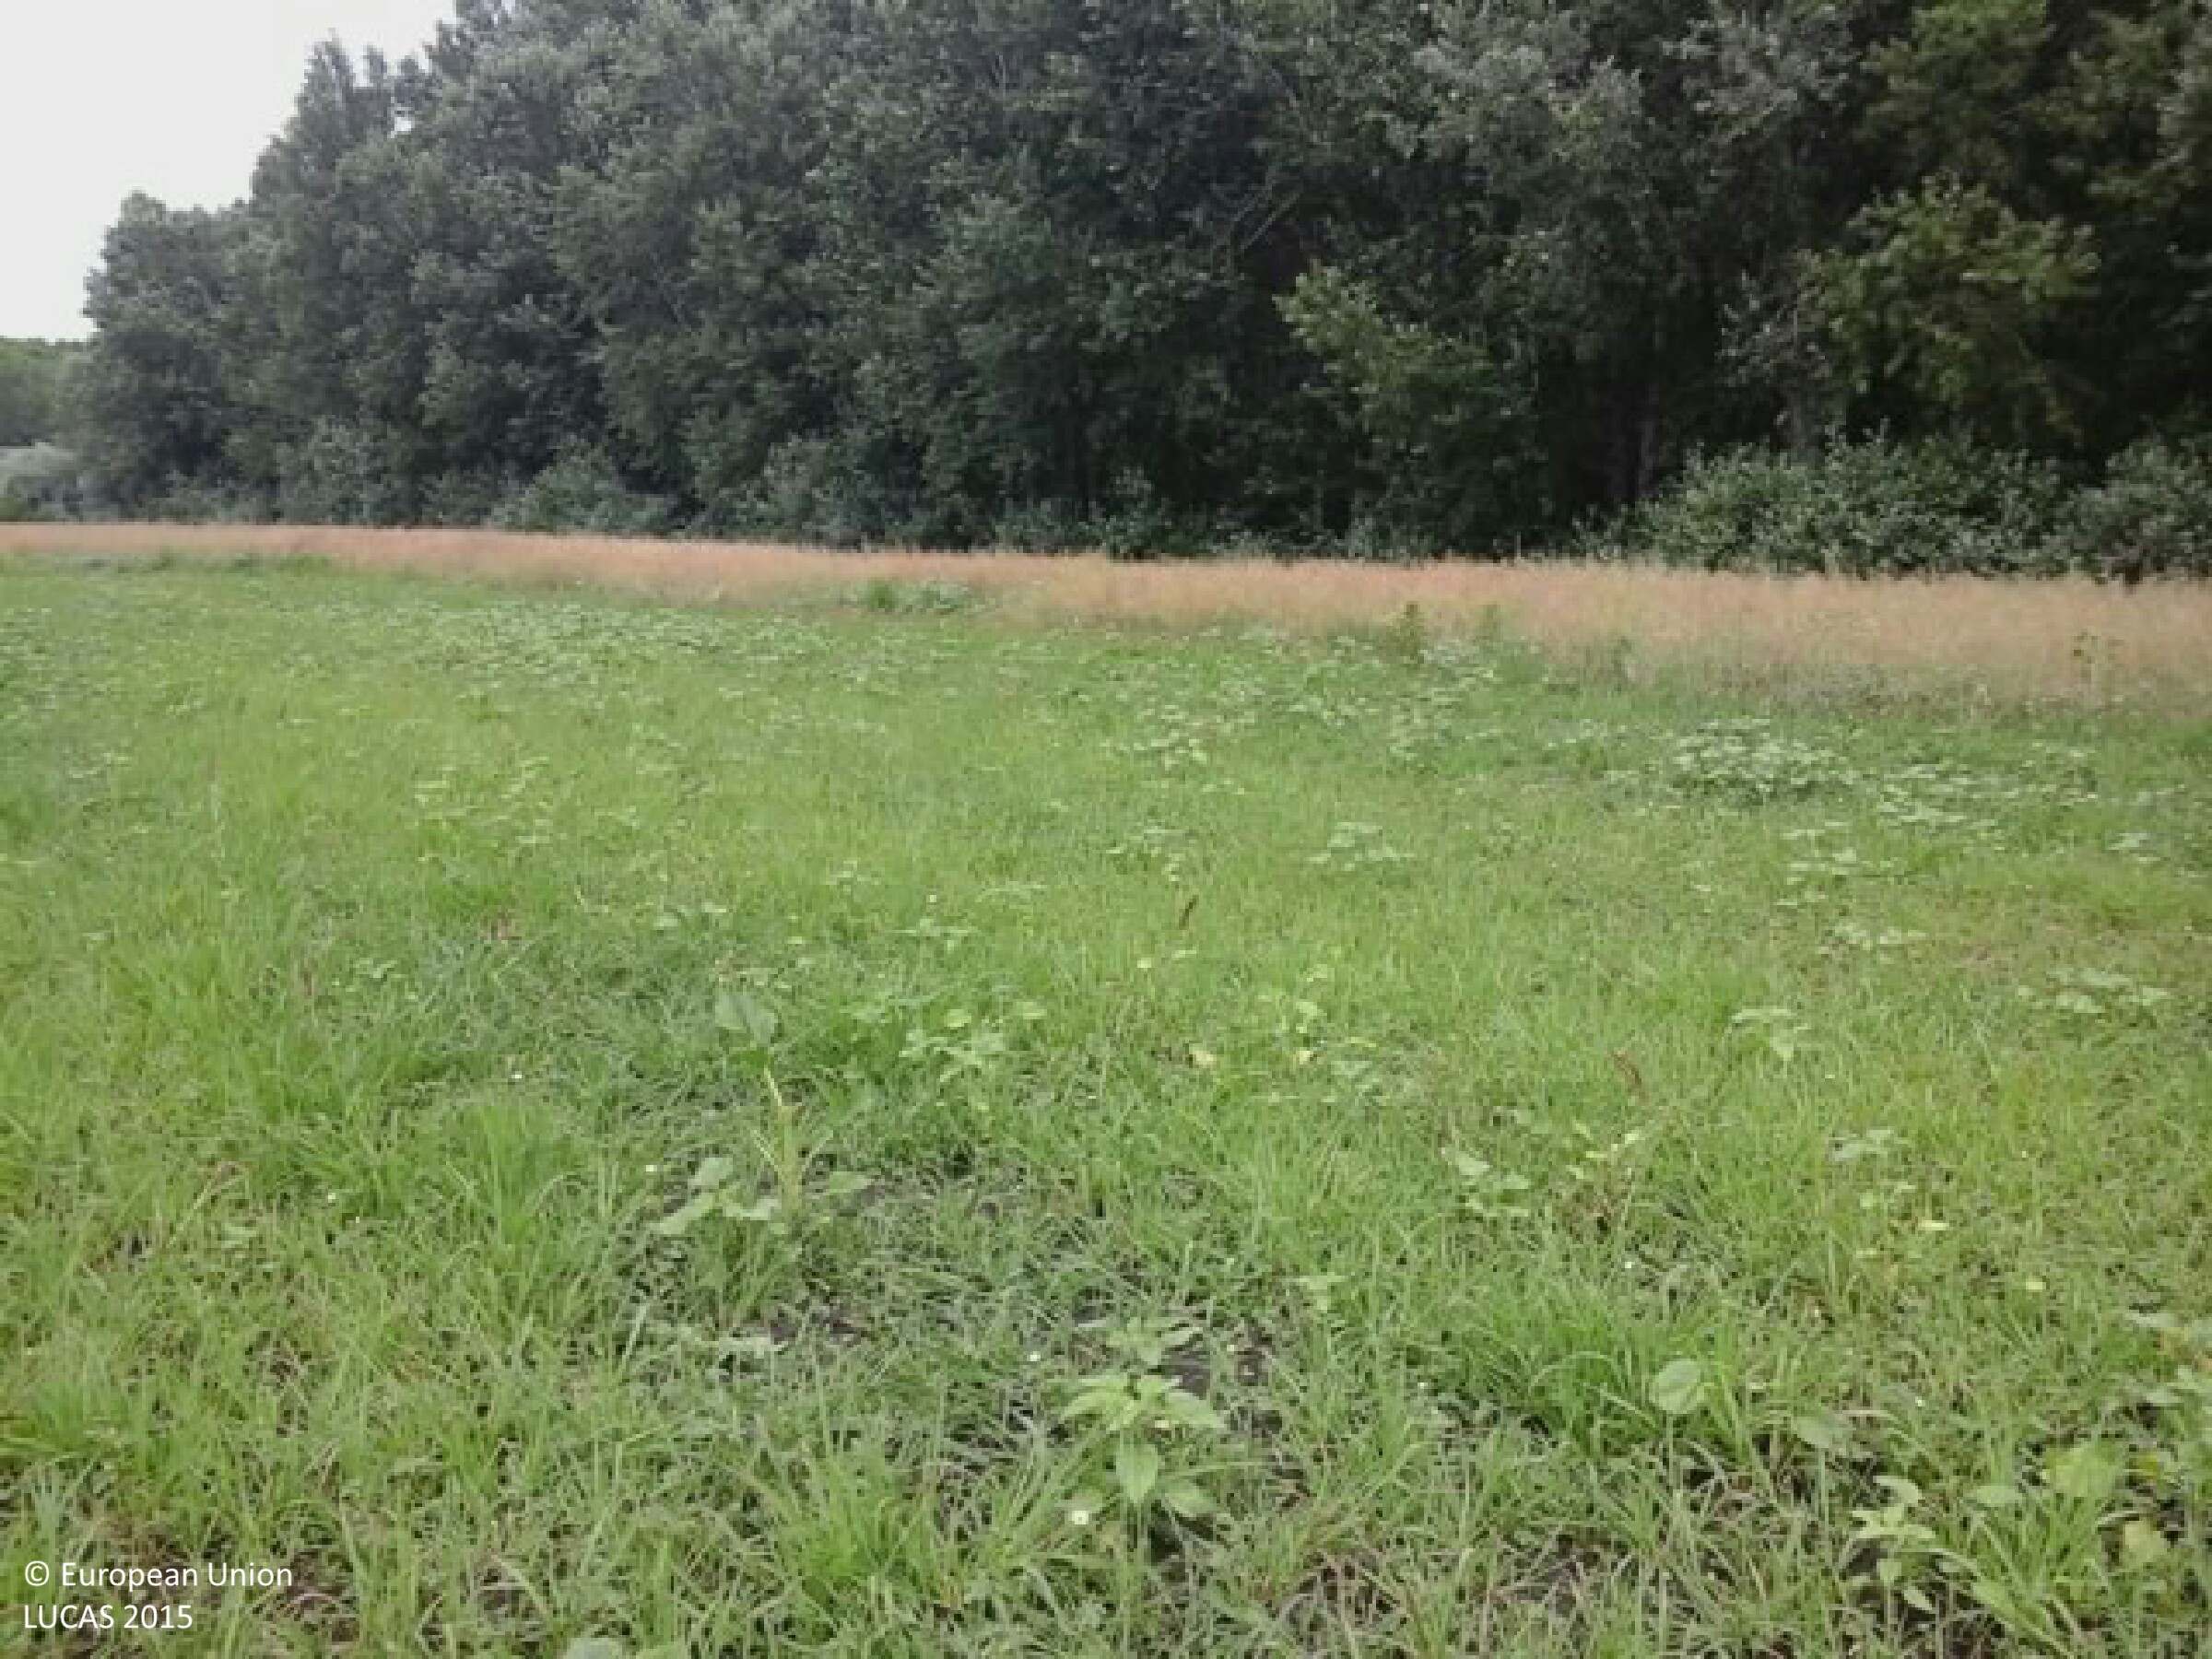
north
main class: Grassland
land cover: Spontaneously vegetated surfaces
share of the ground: > 75 %
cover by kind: herbaceous plants 100 %
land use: Fallow land
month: June
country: HU
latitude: 46.5584
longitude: 20.1325
